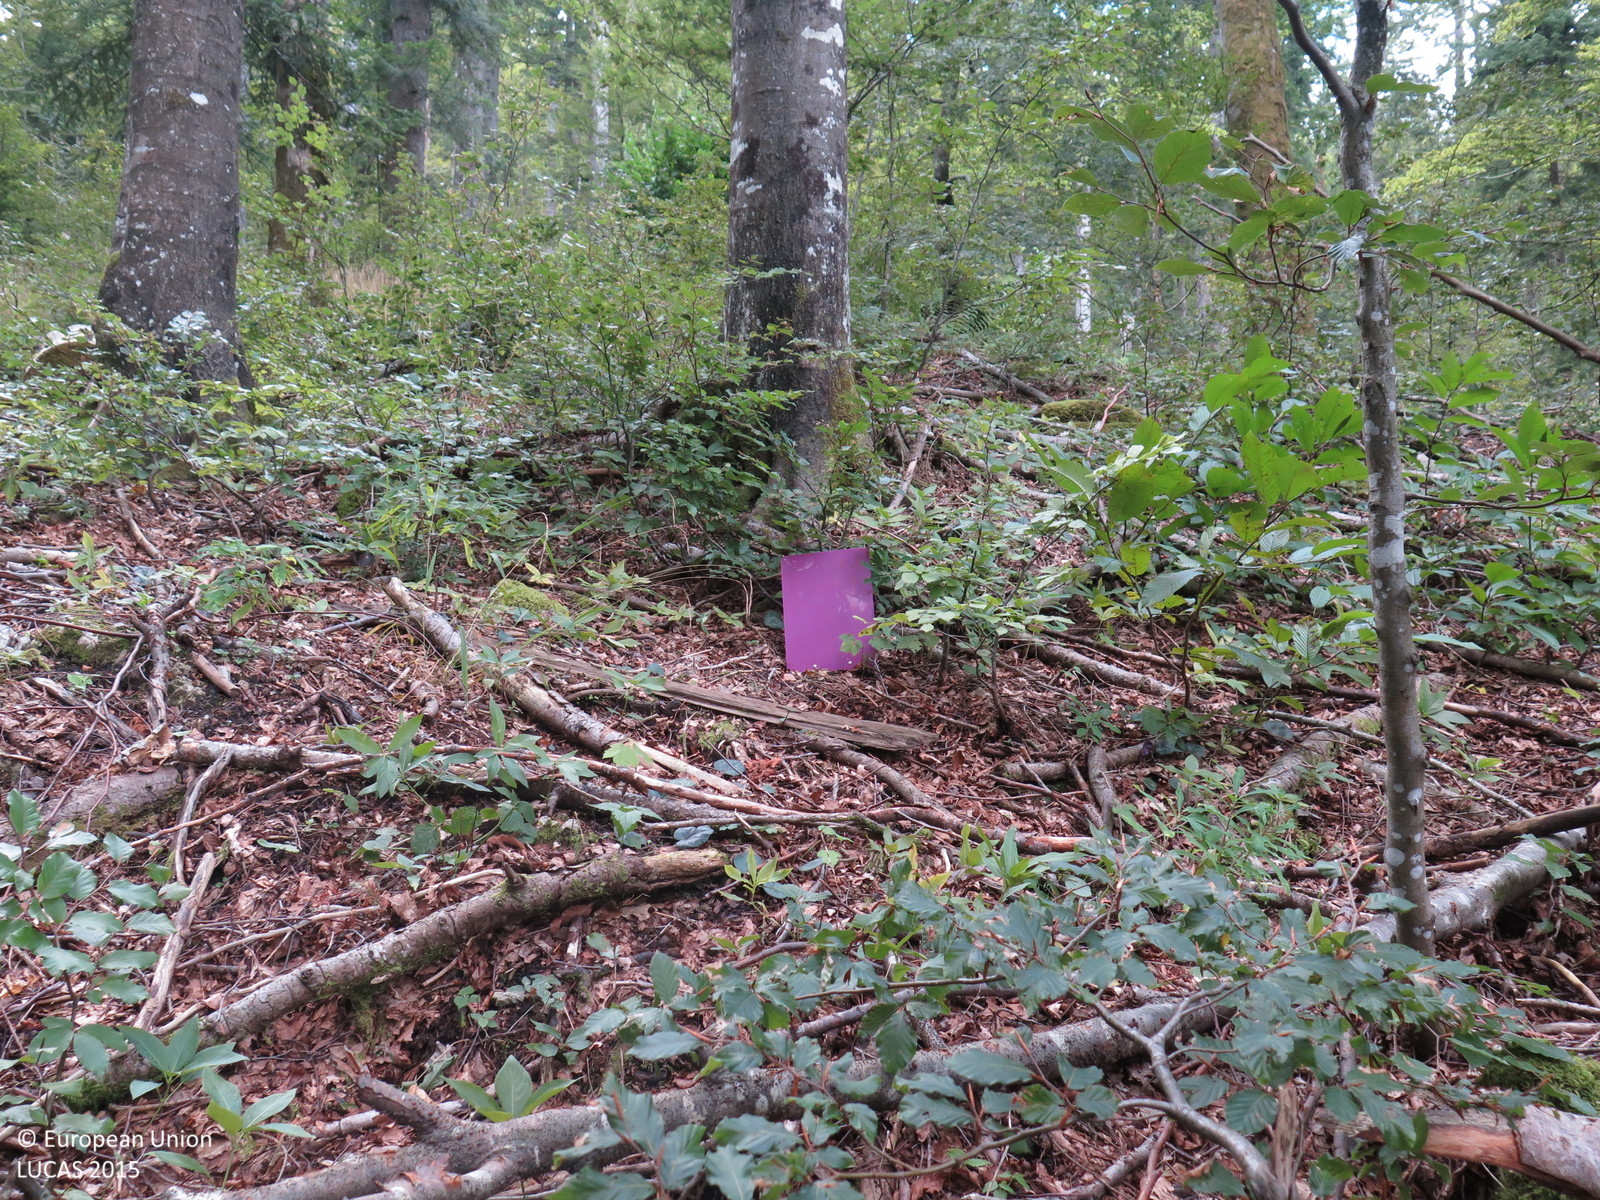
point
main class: Woodland
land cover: Other mixed woodland
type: mountainous beech forest
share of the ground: > 75 %
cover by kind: broadleaved forest trees 75 %, coniferous forest trees 25 %
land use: Forestry
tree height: > 5 m
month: September
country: HR
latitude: 45.3791
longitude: 14.7585
